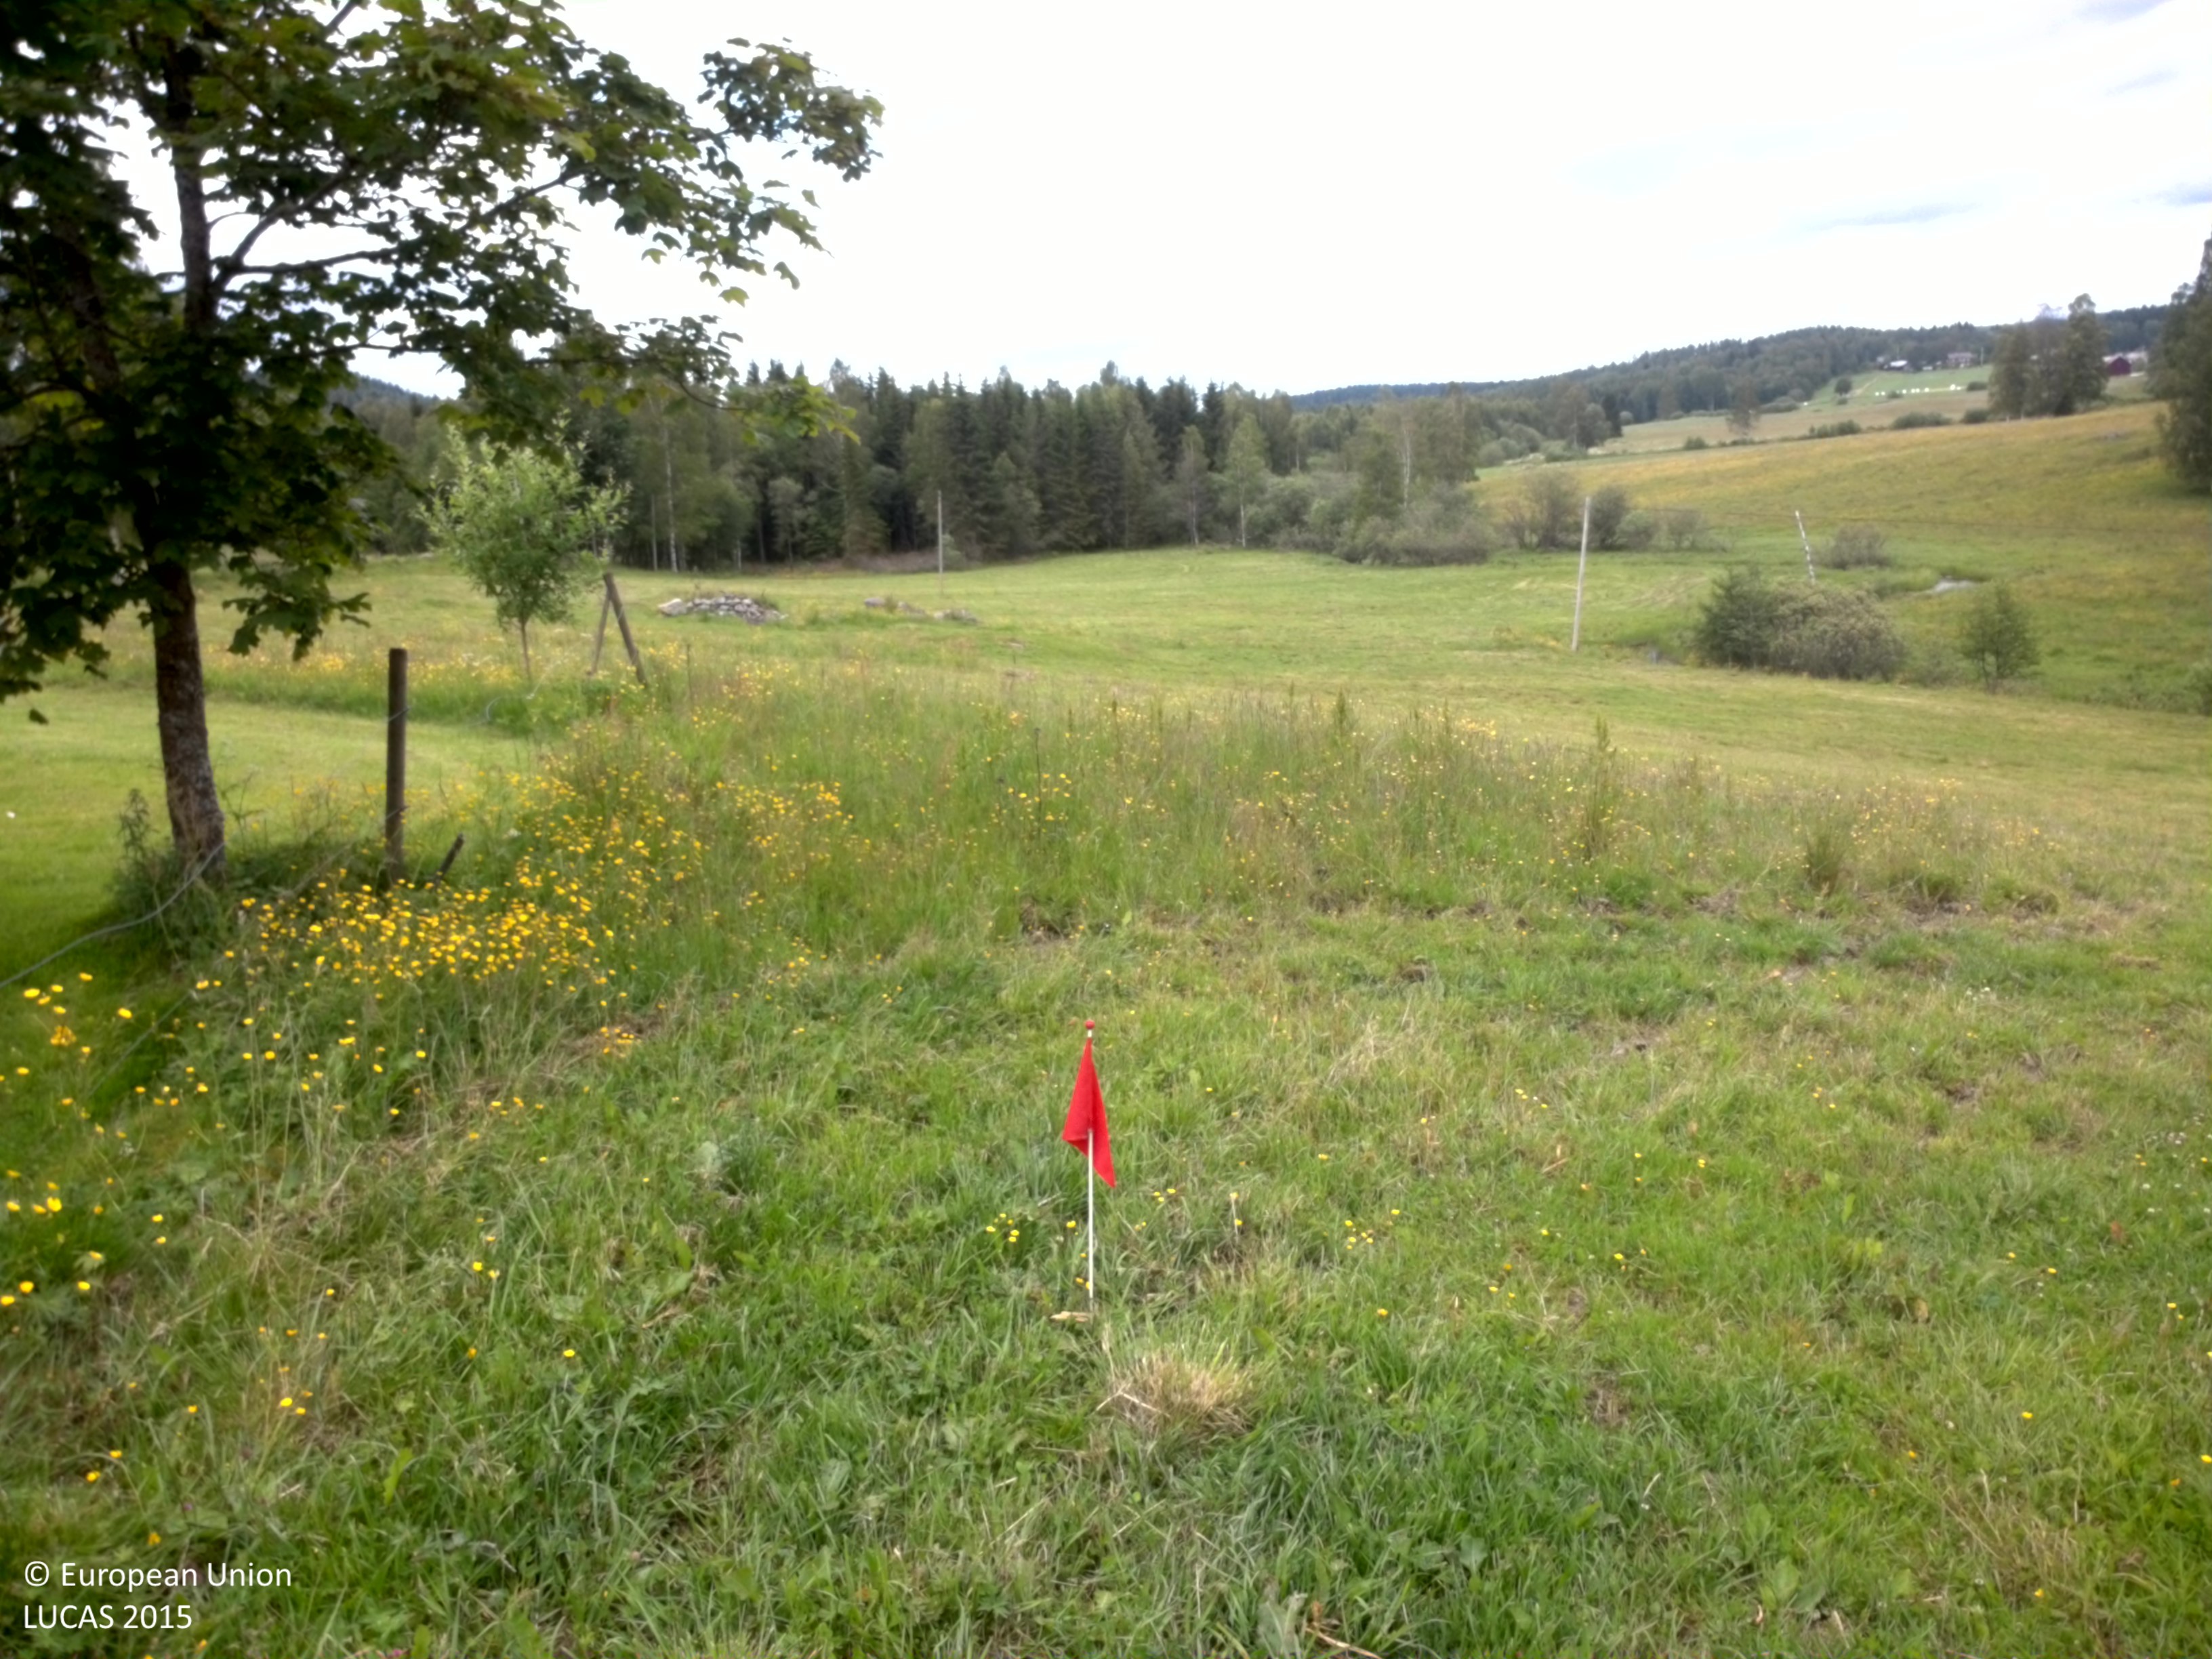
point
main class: Grassland
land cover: Grassland without tree/shrub cover
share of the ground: > 75 %
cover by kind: herbaceous plants 90 %, unconsolidated bare surface 10 %
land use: Agriculture (excluding fallow land and kitchen gardens)
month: June
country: SE
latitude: 59.7815
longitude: 12.4337
